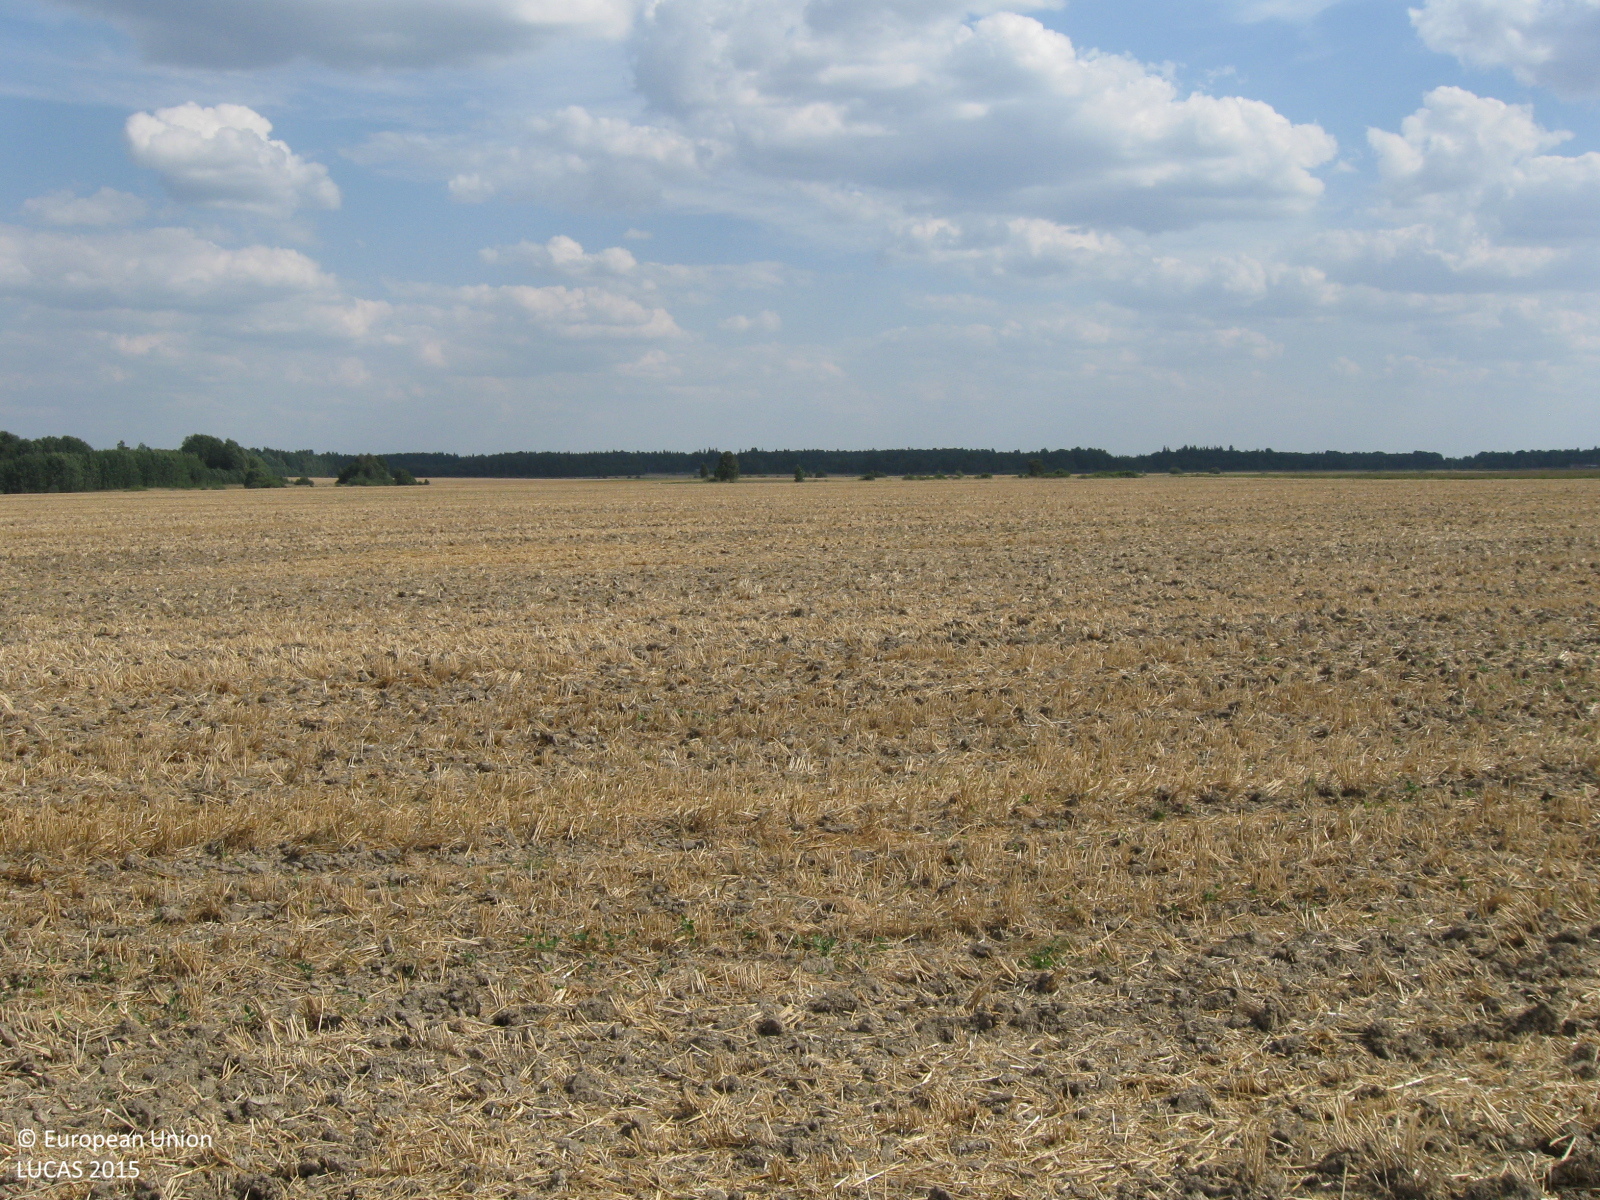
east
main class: Cropland
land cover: Common wheat
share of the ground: < 10 %
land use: Agriculture (excluding fallow land and kitchen gardens)
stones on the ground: < 10 %
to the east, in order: Common wheat
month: August
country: LT
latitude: 55.5169
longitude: 22.8800
